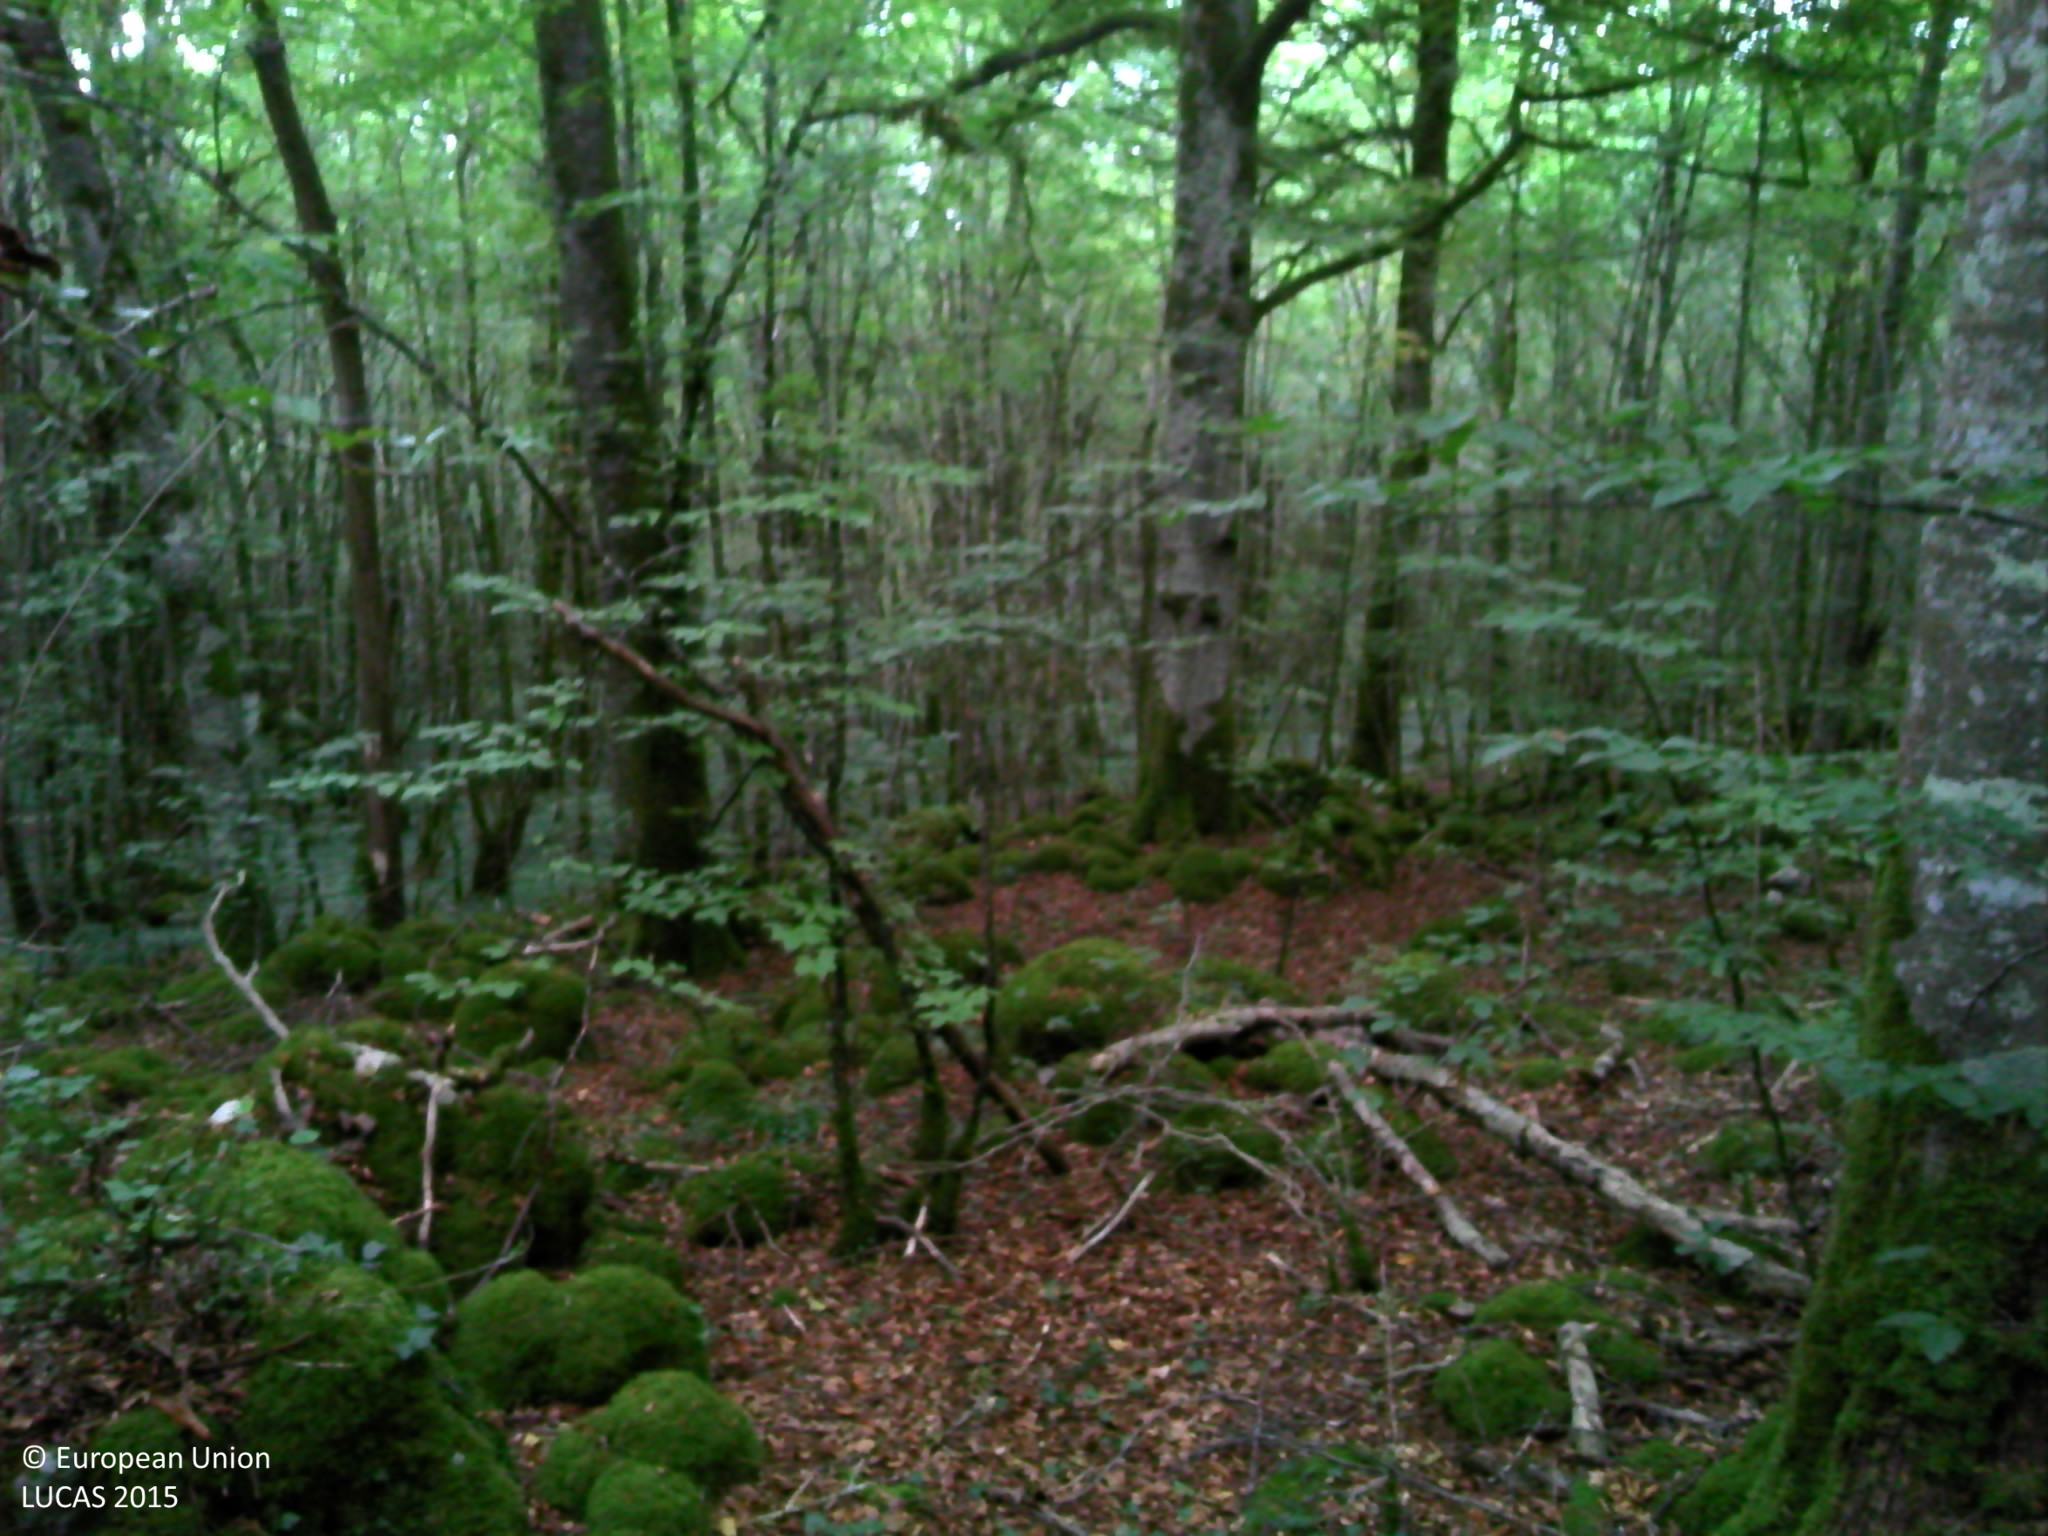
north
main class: Woodland
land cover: Broadleaved woodland
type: mesophytic deciduous forest
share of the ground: > 75 %
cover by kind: broadleaved forest trees 90 %, herbaceous plants 5 %, lichens and mosses 5 %
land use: Forestry
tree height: > 5 m
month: August
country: FR
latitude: 47.7356
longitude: 4.7051
